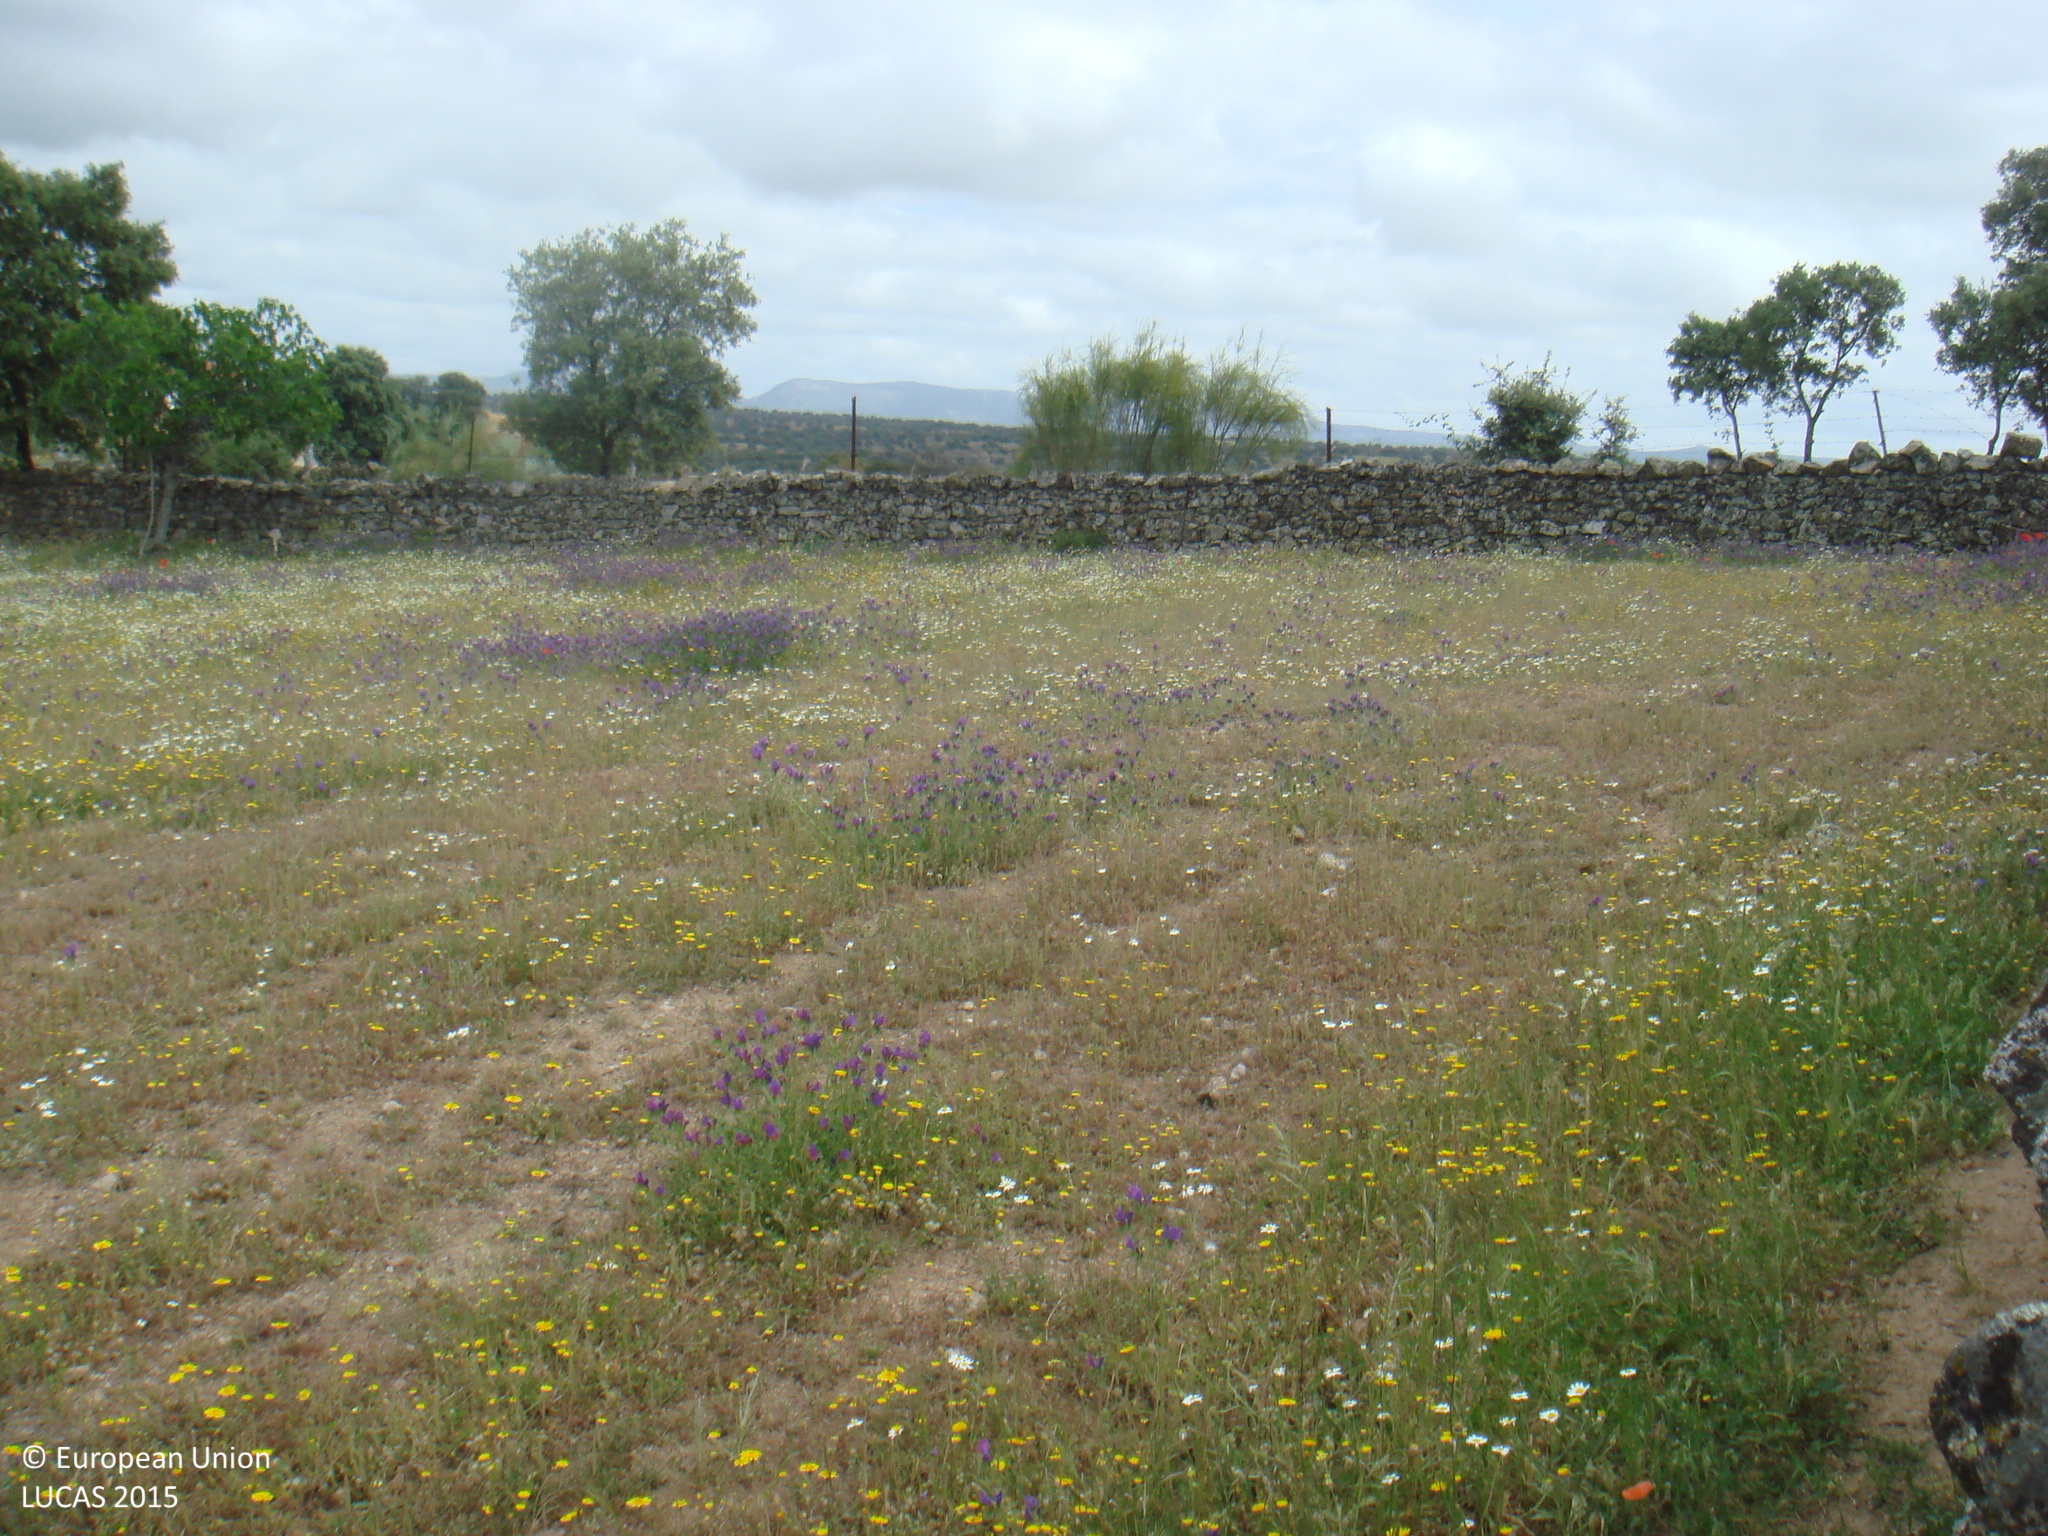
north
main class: Grassland
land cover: Grassland without tree/shrub cover
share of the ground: > 75 %
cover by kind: herbaceous plants 100 %
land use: Agriculture (excluding fallow land and kitchen gardens)
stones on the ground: < 10 %
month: May
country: ES
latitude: 38.4481
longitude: -4.7468
